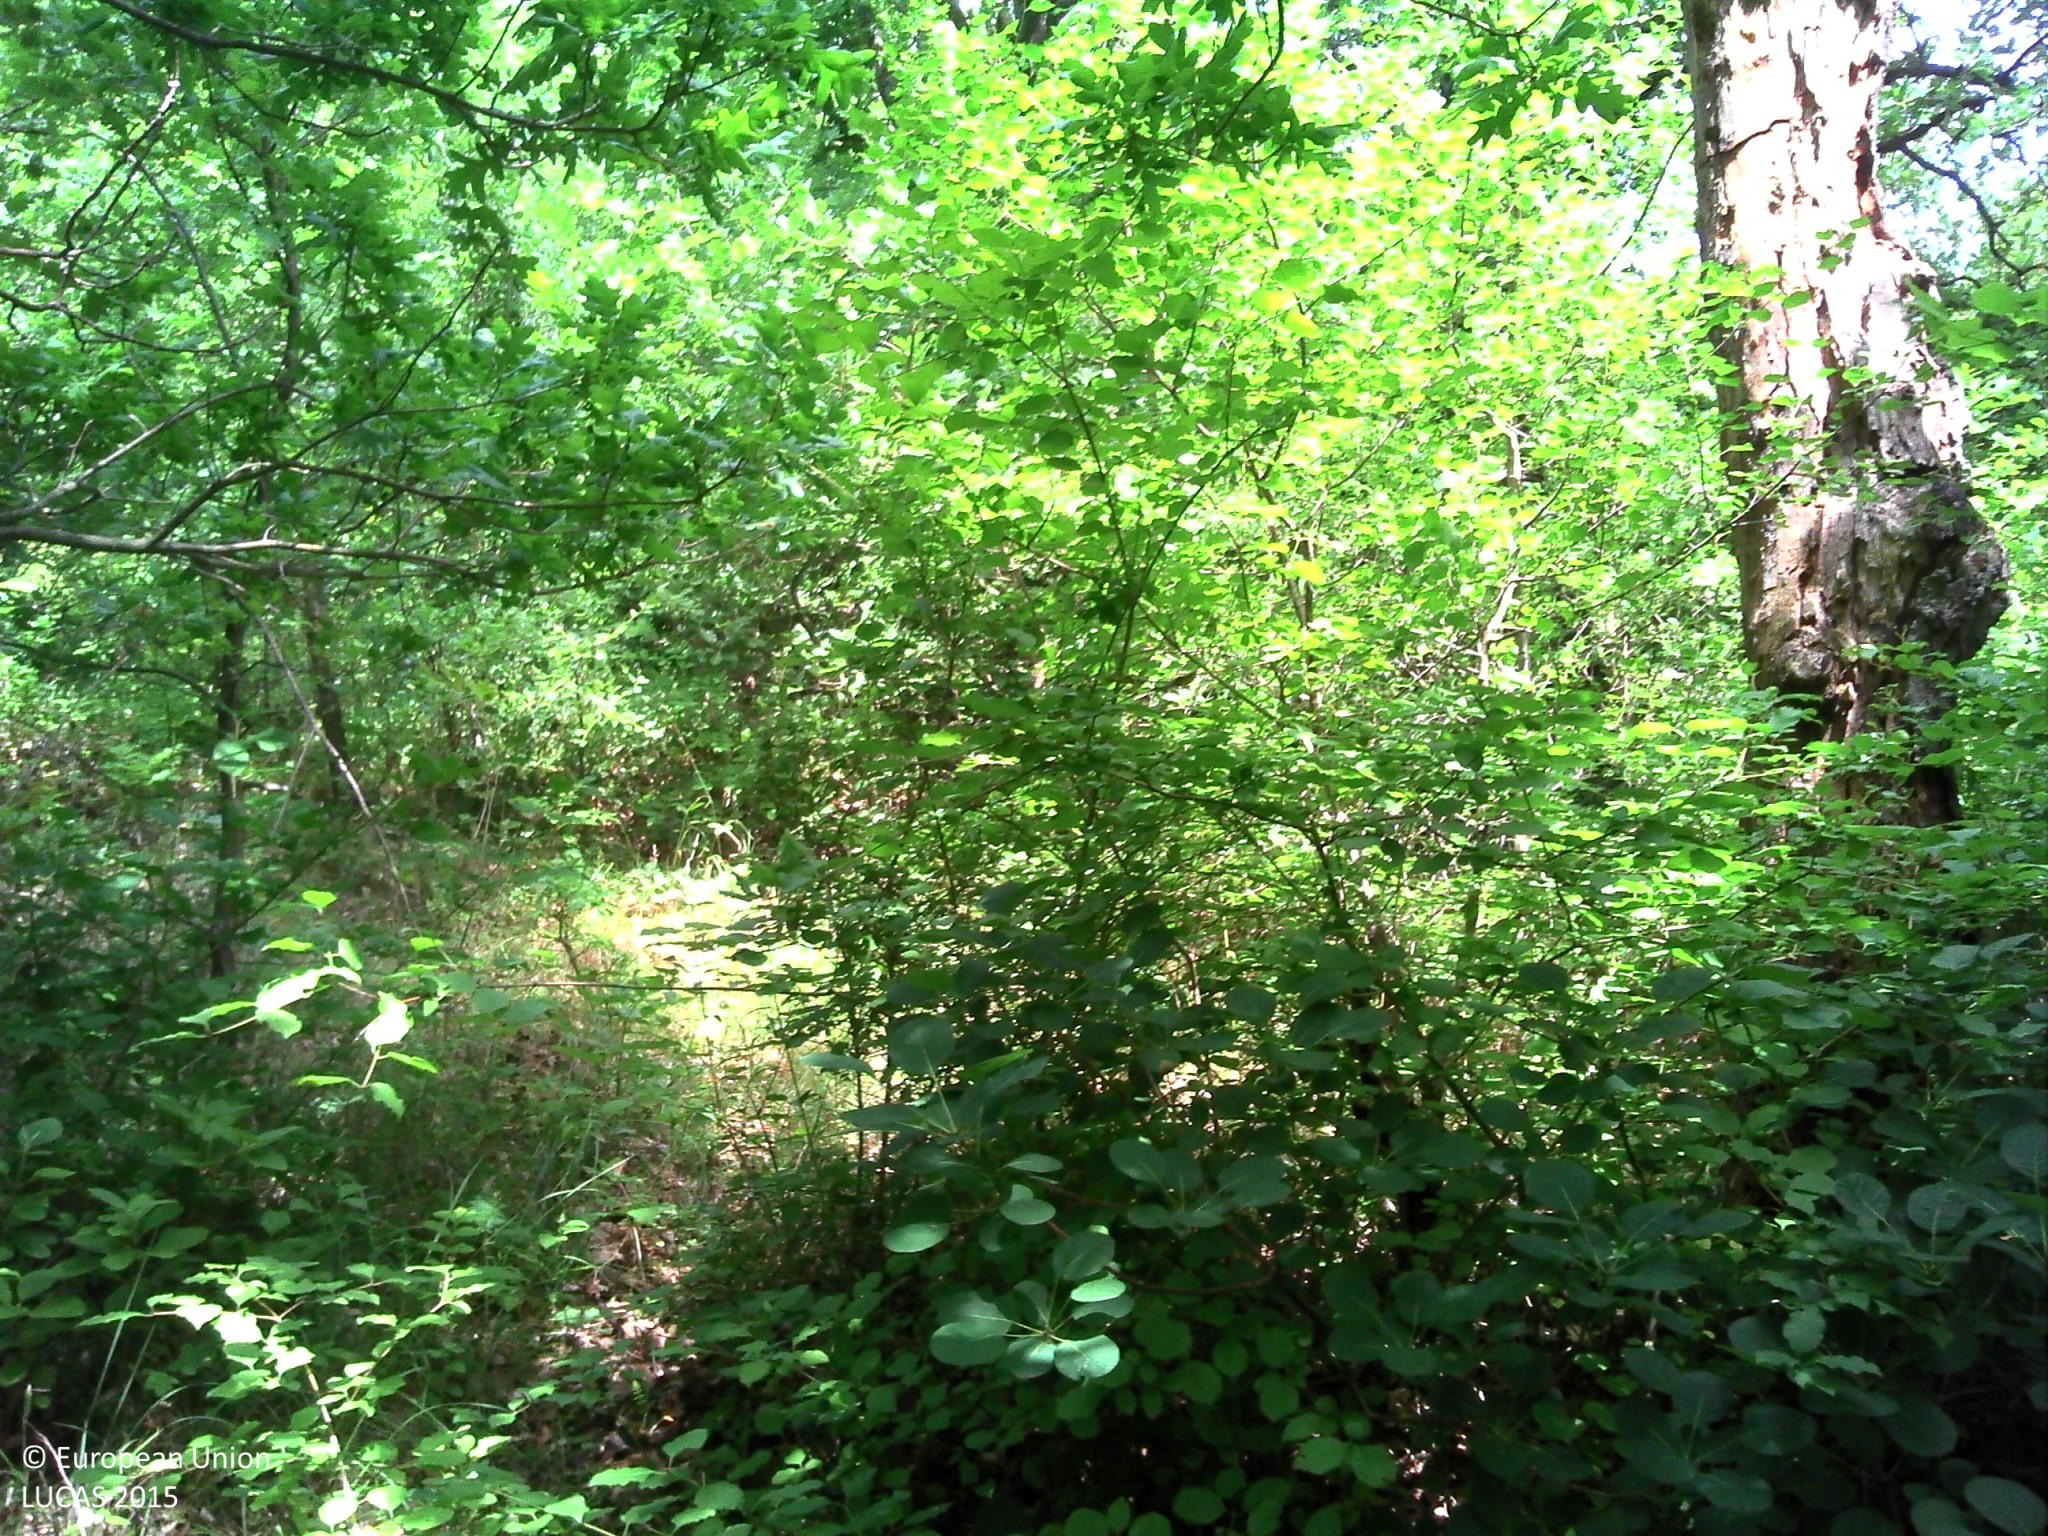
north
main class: Woodland
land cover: Broadleaved woodland
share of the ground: > 75 %
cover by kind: broadleaved forest trees 100 %
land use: Forestry
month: June
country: FR
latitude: 44.6492
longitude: 5.0764
